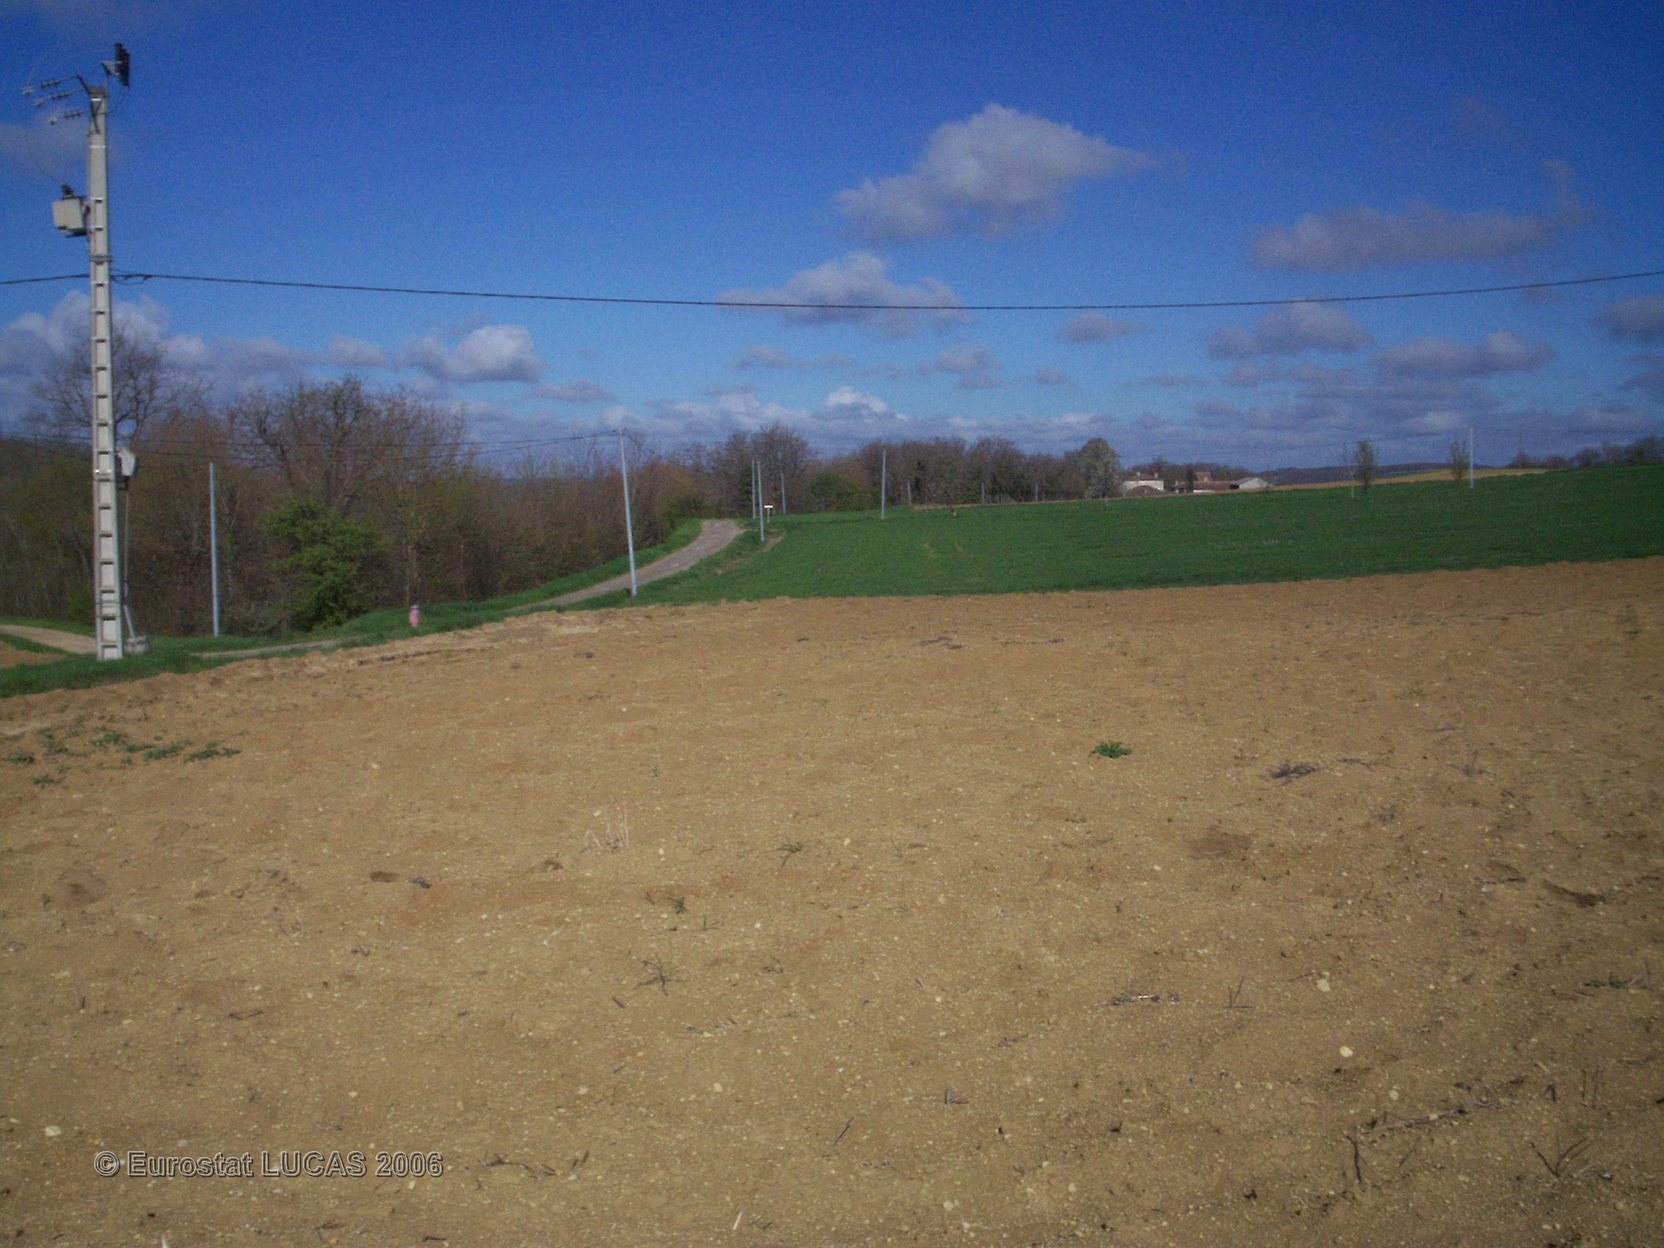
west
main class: Cropland
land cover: Sunflower
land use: Agriculture (excluding fallow land and kitchen gardens)
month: June
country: FR
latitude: 44.1838
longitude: 0.8769
